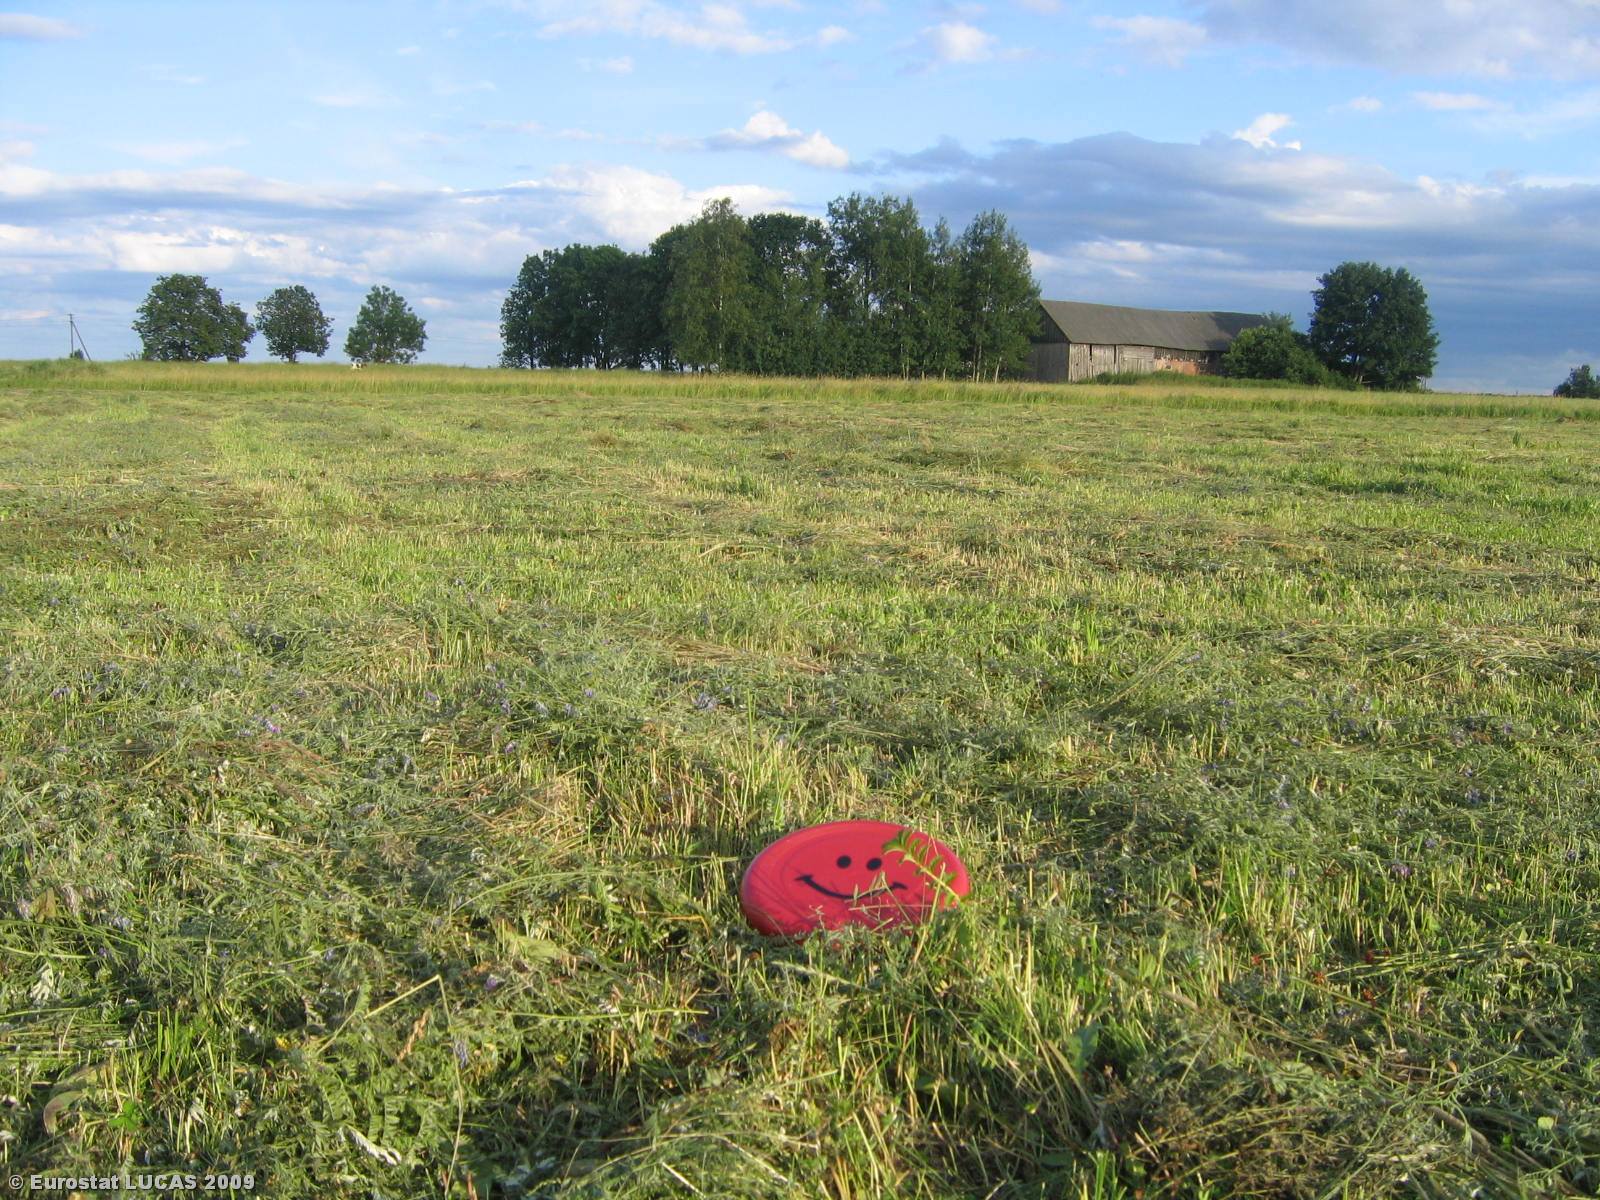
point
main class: Grassland
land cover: Grassland without tree/shrub cover
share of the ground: > 75 %
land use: Agriculture (excluding fallow land and kitchen gardens)
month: July
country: LT
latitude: 55.4030
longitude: 22.7463
